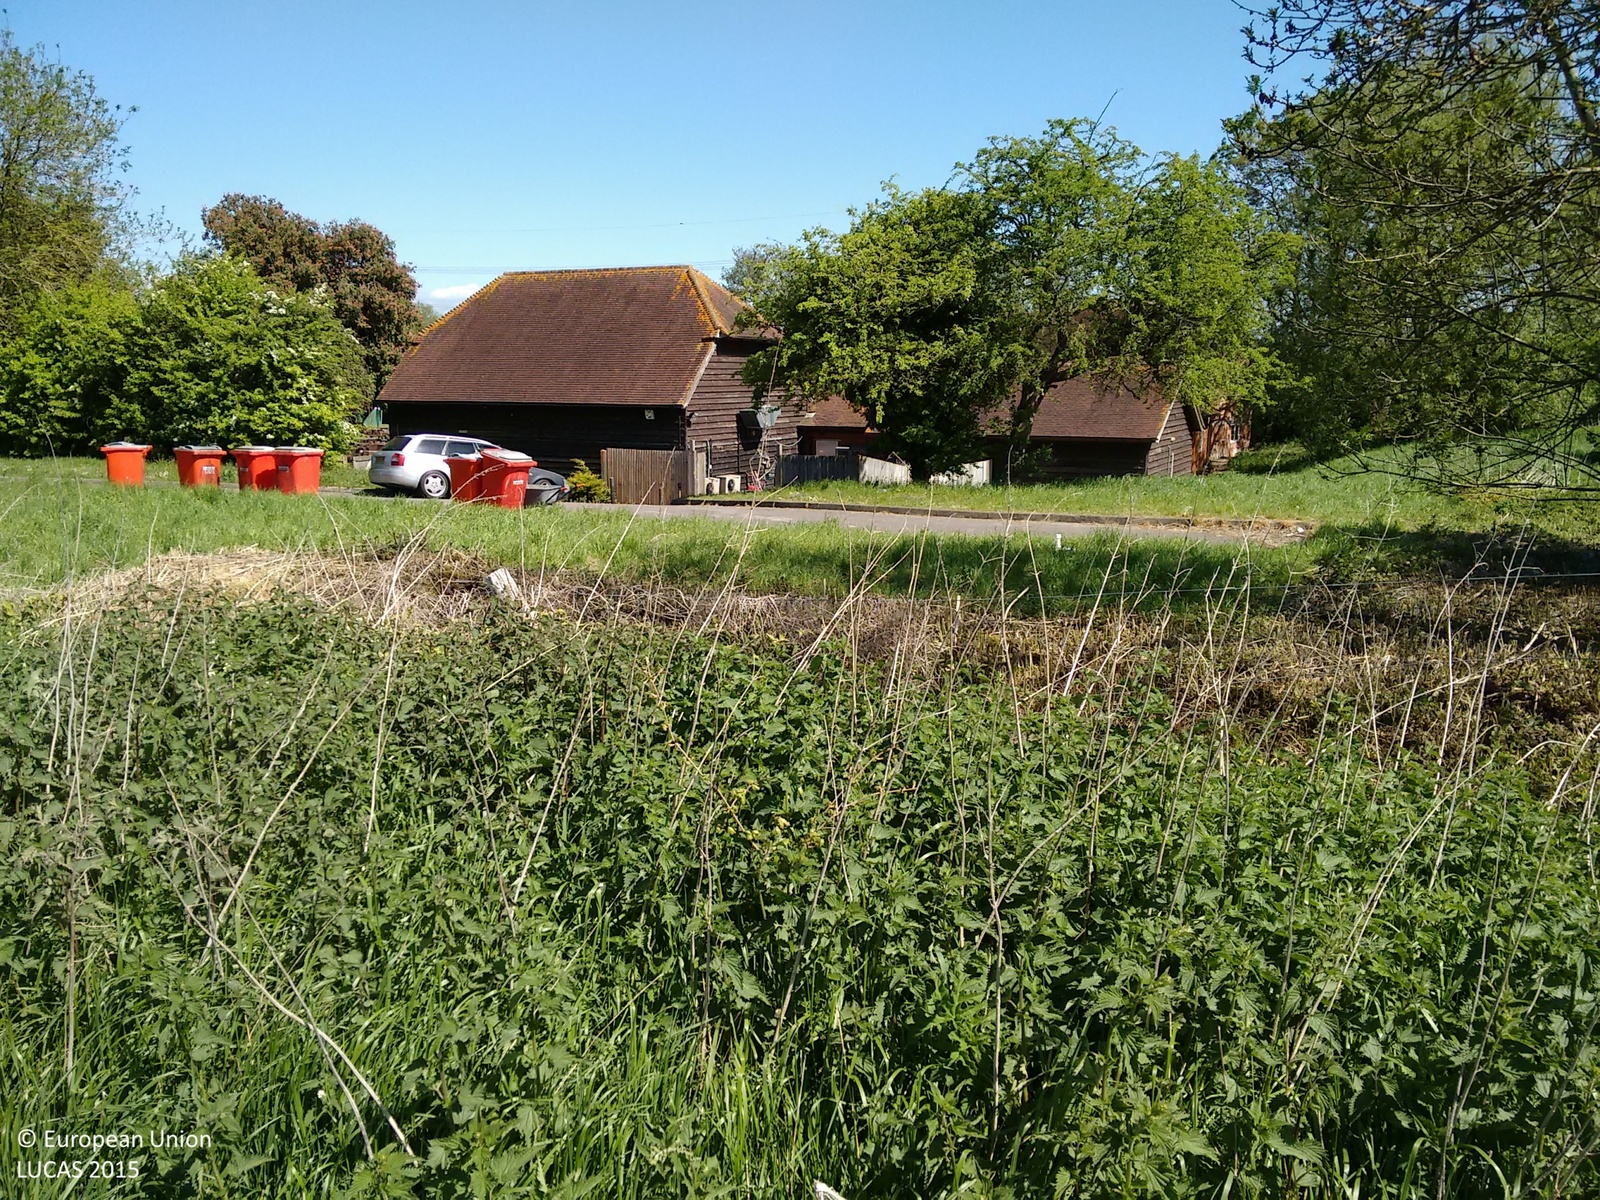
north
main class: Cropland
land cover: Barley
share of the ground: > 75 %
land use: Agriculture (excluding fallow land and kitchen gardens)
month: May
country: GB
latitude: 51.3180
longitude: -1.0212
